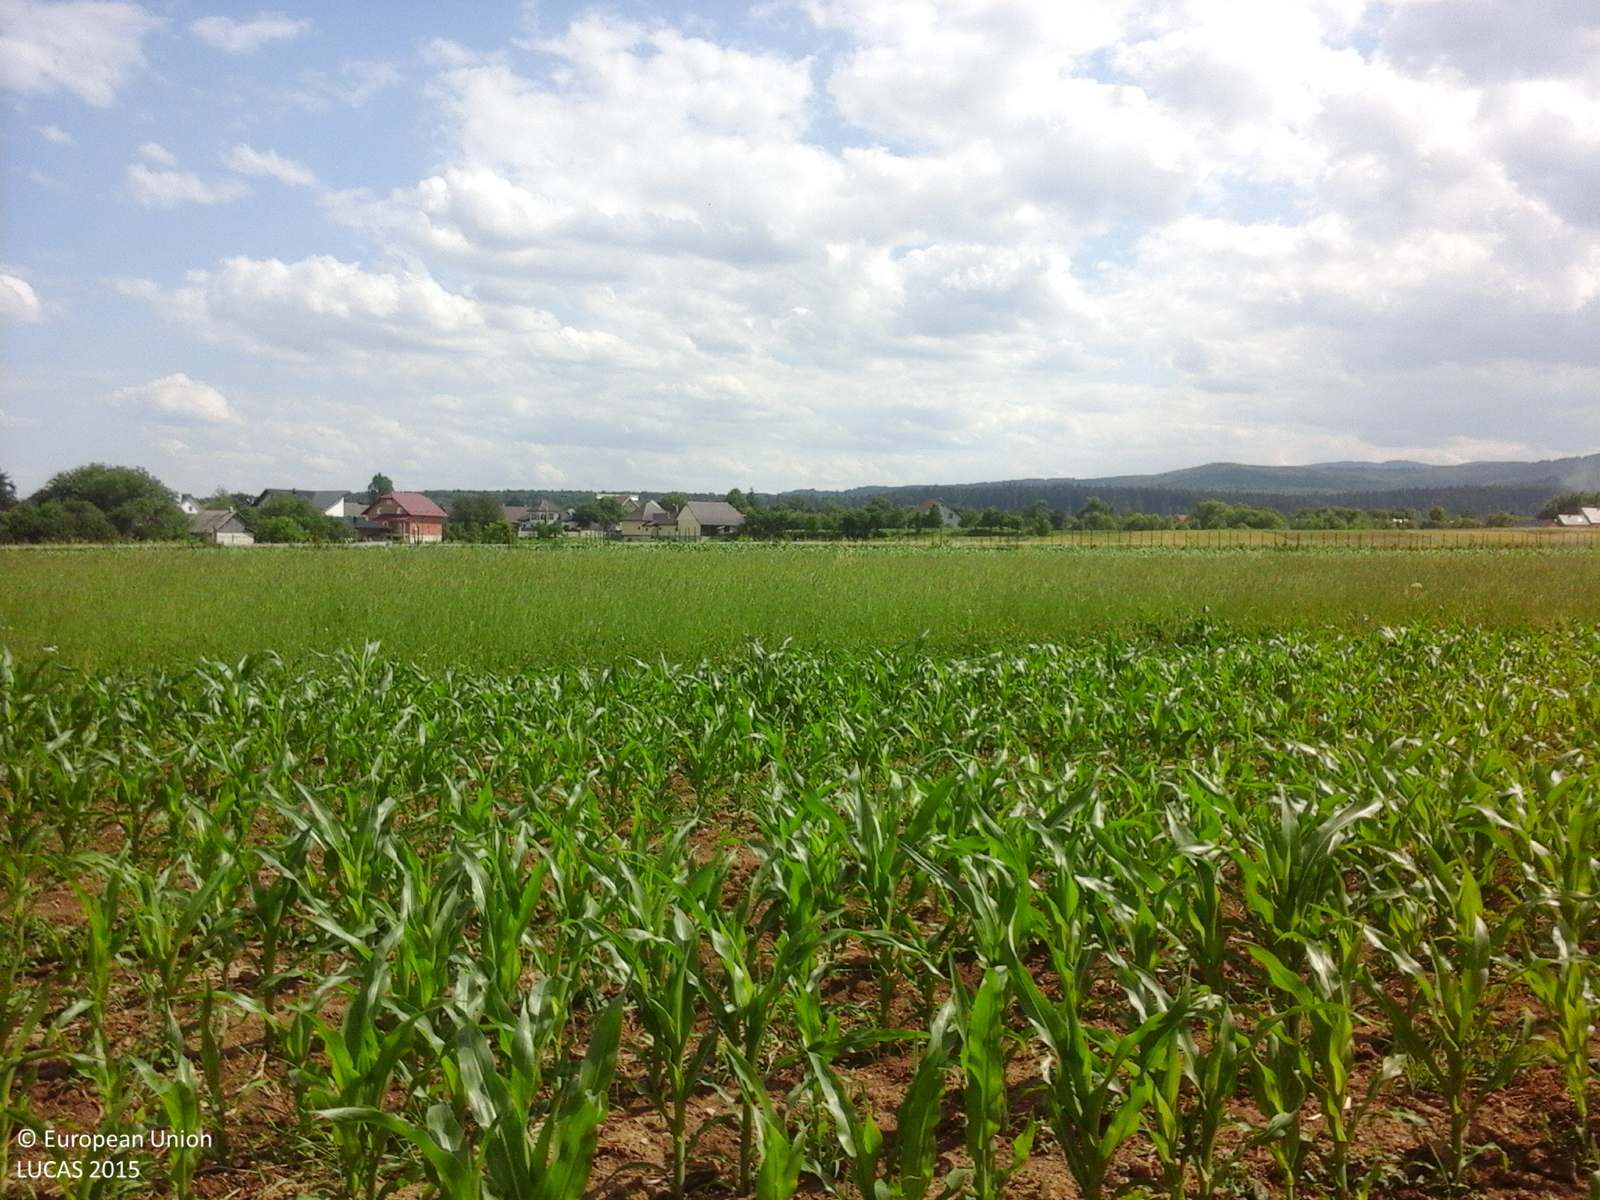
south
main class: Cropland
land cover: Maize
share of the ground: 25 - 50 %
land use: Agriculture (excluding fallow land and kitchen gardens)
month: June
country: RO
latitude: 47.8057
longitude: 25.8154
